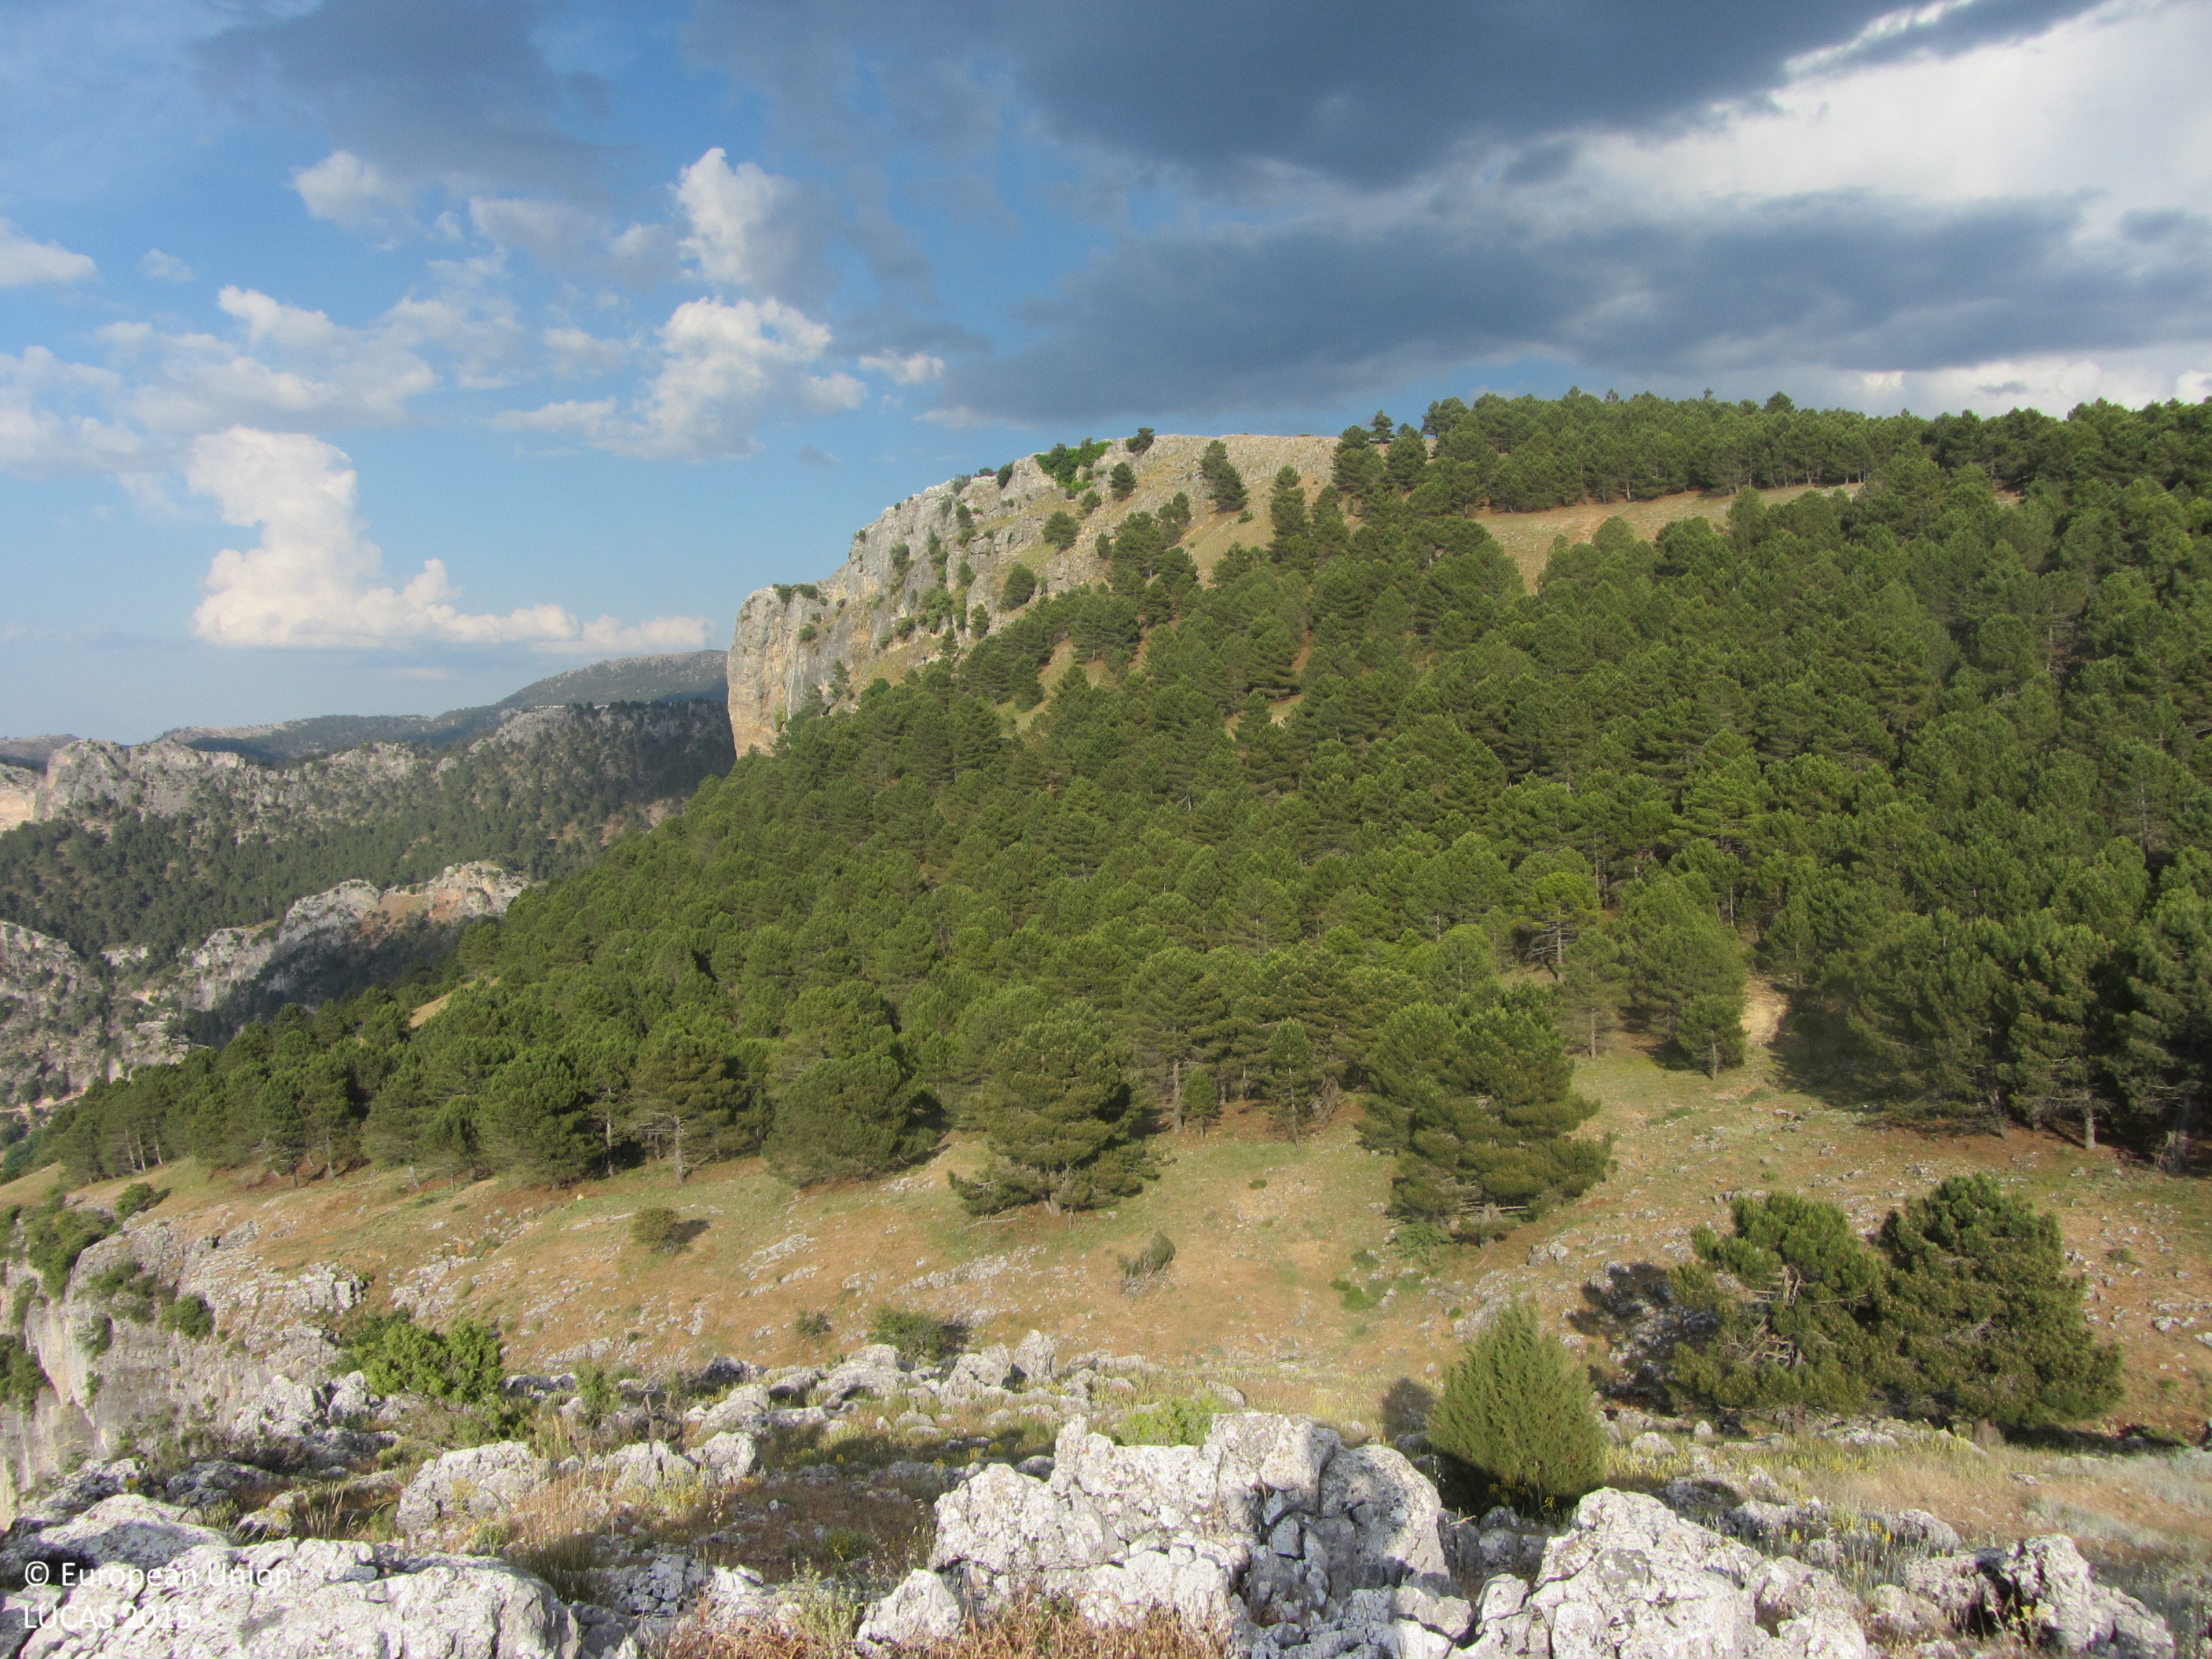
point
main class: Woodland
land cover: Pine dominated coniferous woodland
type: coniferous forest of the mediterranean region
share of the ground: 50 - 75 %
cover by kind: coniferous forest trees 70 %, herbaceous plants 30 %
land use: Semi-natural and natural areas not in use
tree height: > 5 m
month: May
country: ES
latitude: 38.1269
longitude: -2.9224
